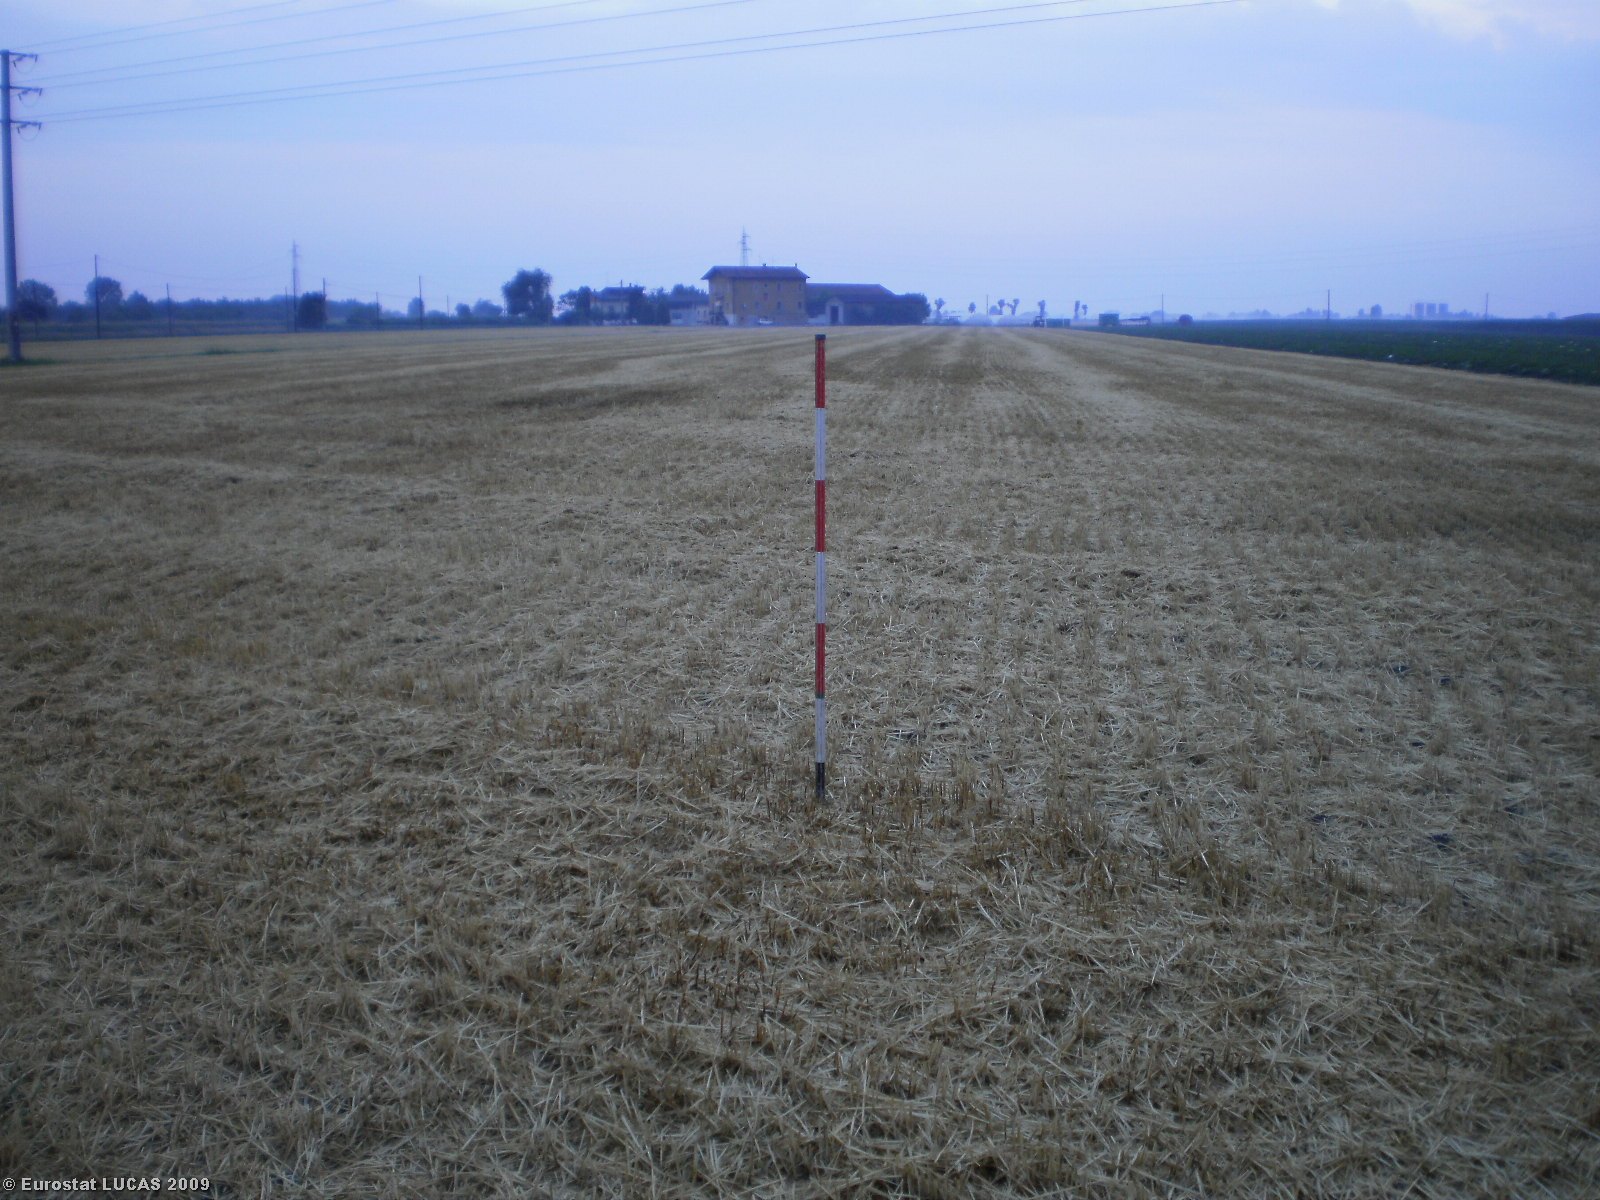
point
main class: Cropland
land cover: Common wheat
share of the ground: > 75 %
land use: Agriculture (excluding fallow land and kitchen gardens)
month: June
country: IT
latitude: 44.9982
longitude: 10.5697
